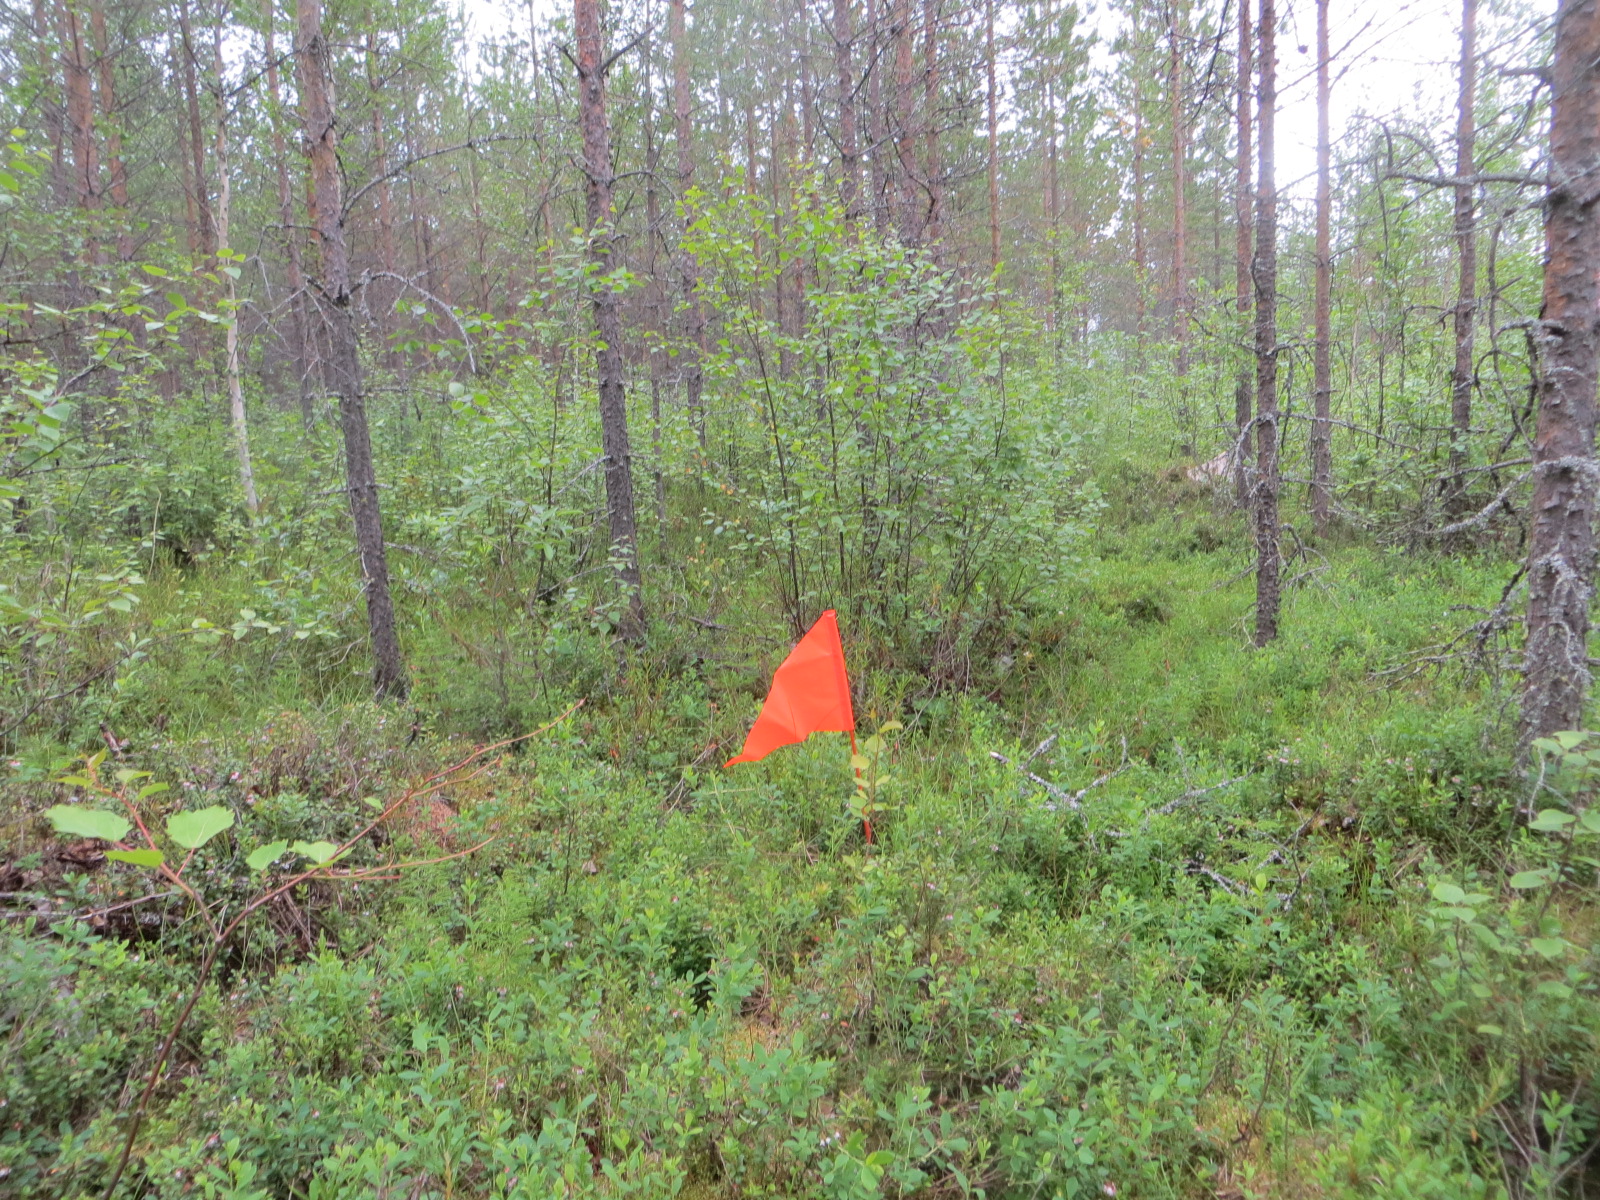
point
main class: Woodland
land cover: Other mixed woodland
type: boreal forest
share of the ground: > 75 %
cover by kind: coniferous forest trees 45 %, broadleaved forest trees 30 %, shrubs 25 %
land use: Forestry
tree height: > 5 m
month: July
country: FI
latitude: 65.8607
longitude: 25.3881
